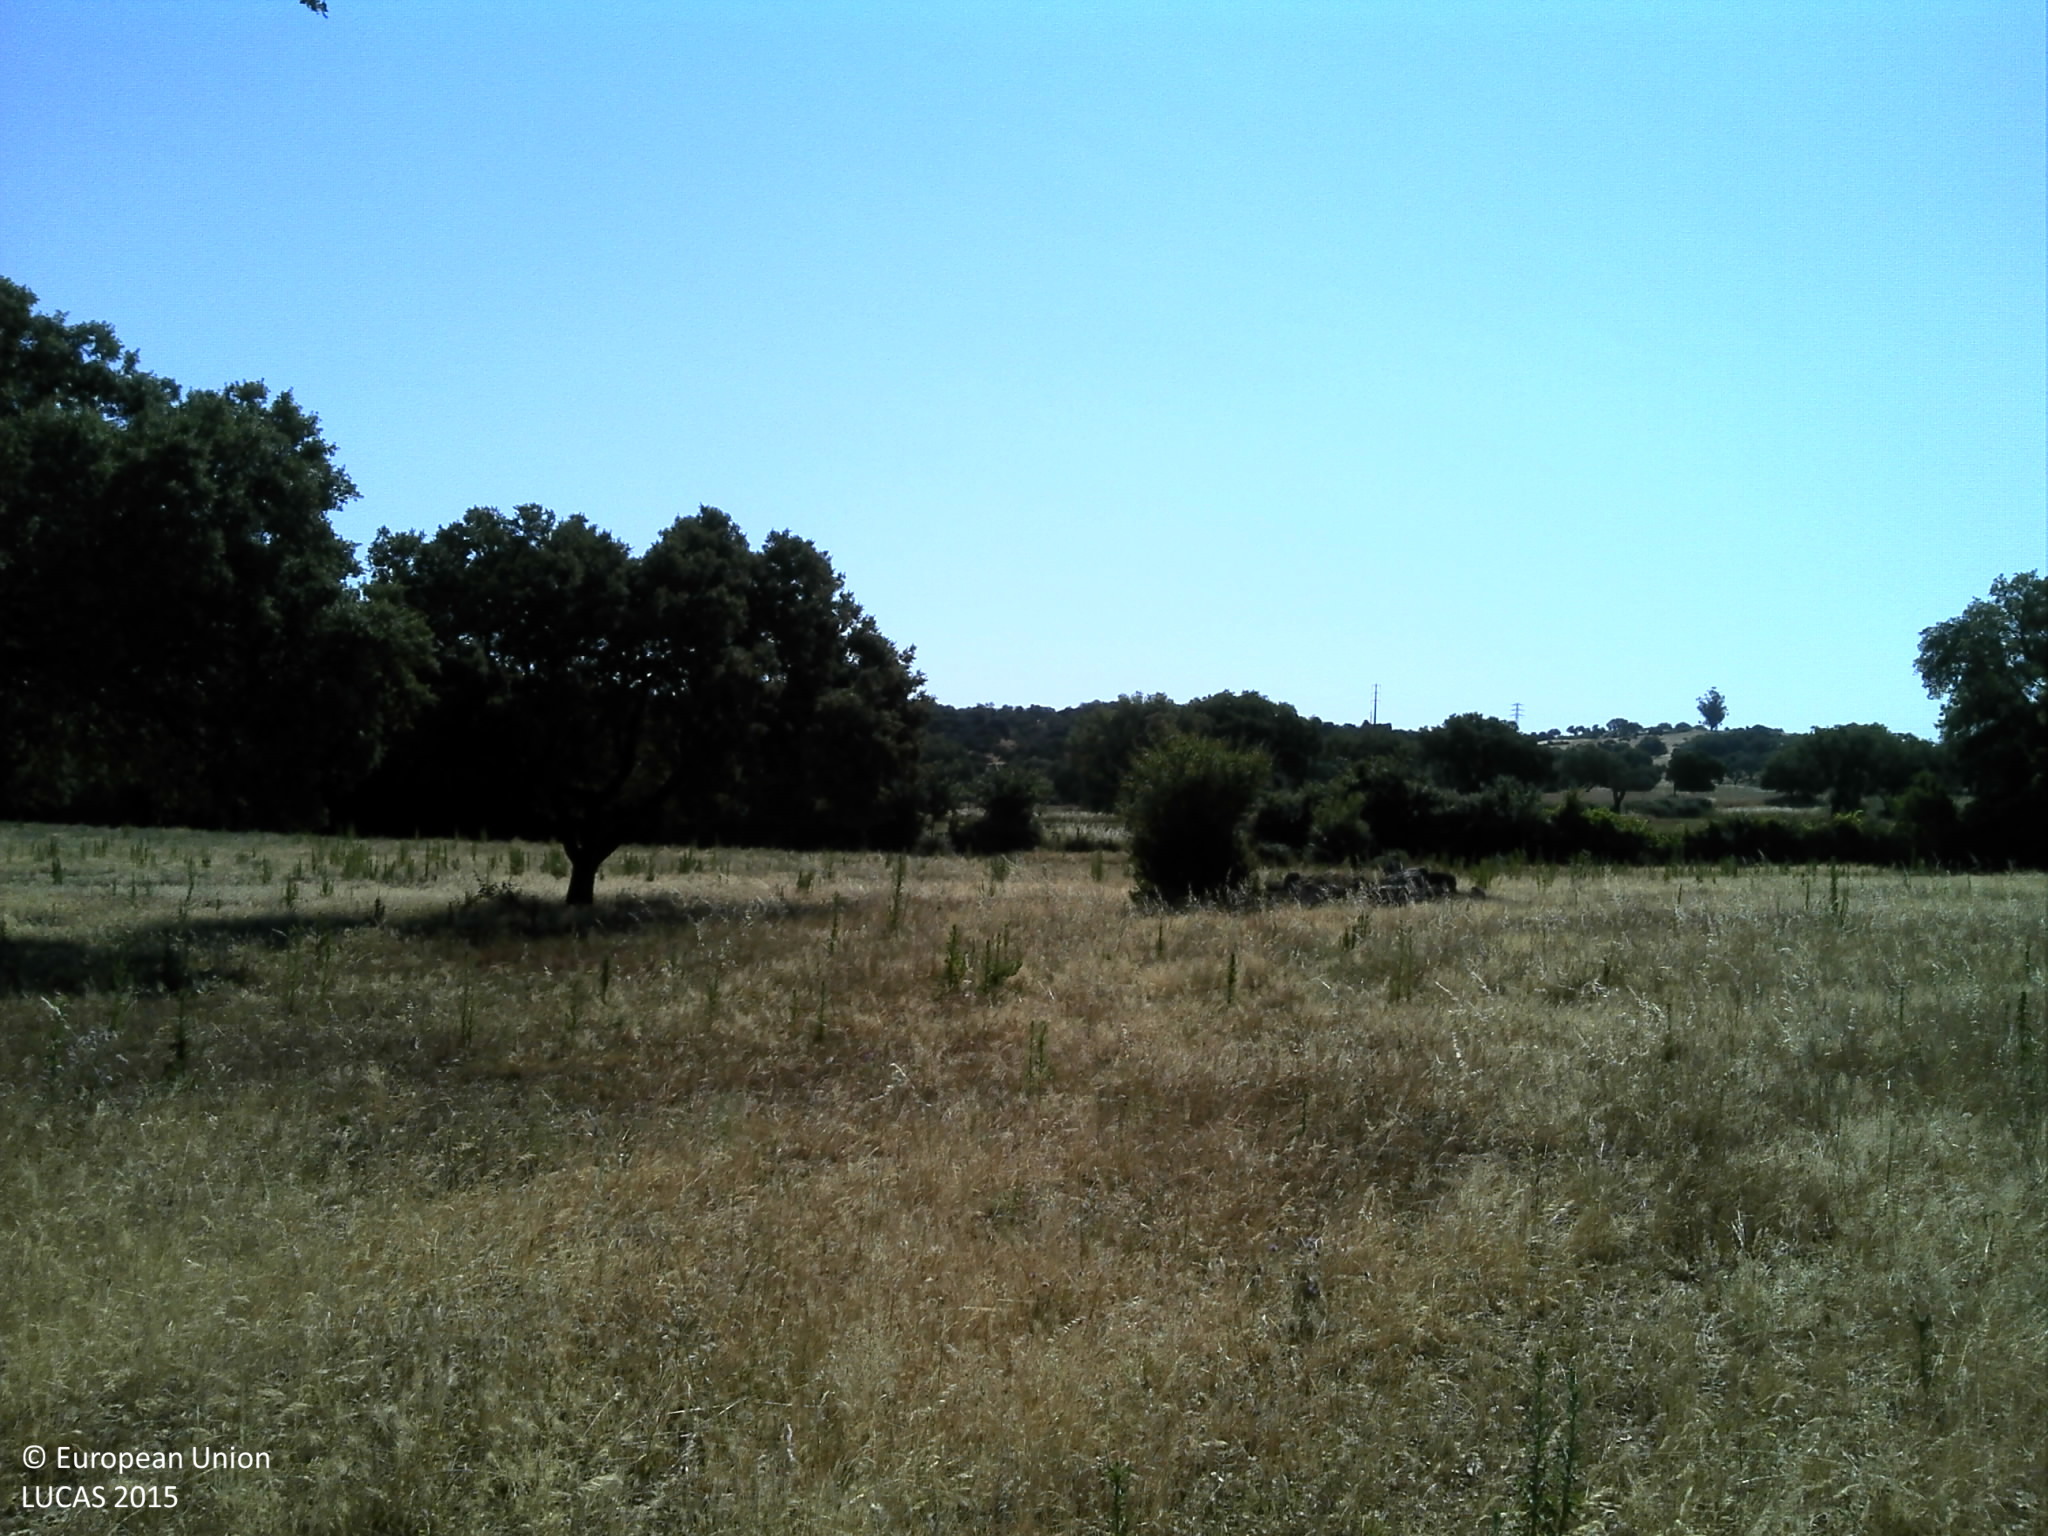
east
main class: Woodland
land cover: Broadleaved woodland
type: broadleaved evergreen forest
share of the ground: 10 - 25 %
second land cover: Spontaneously vegetated surfaces
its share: 25 - 50 %
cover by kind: herbaceous plants 50 %, unconsolidated bare surface 30 %, broadleaved forest trees 20 %
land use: Forestry
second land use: Agriculture (excluding fallow land and kitchen gardens)
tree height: > 5 m
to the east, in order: Broadleaved woodland; Spontaneously vegetated surfaces; Broadleaved woodland; Fences; Mixed cereals for fodder; Single bushes/trees; Mixed cereals for fodder
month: June
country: PT
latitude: 38.6120
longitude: -8.0628
